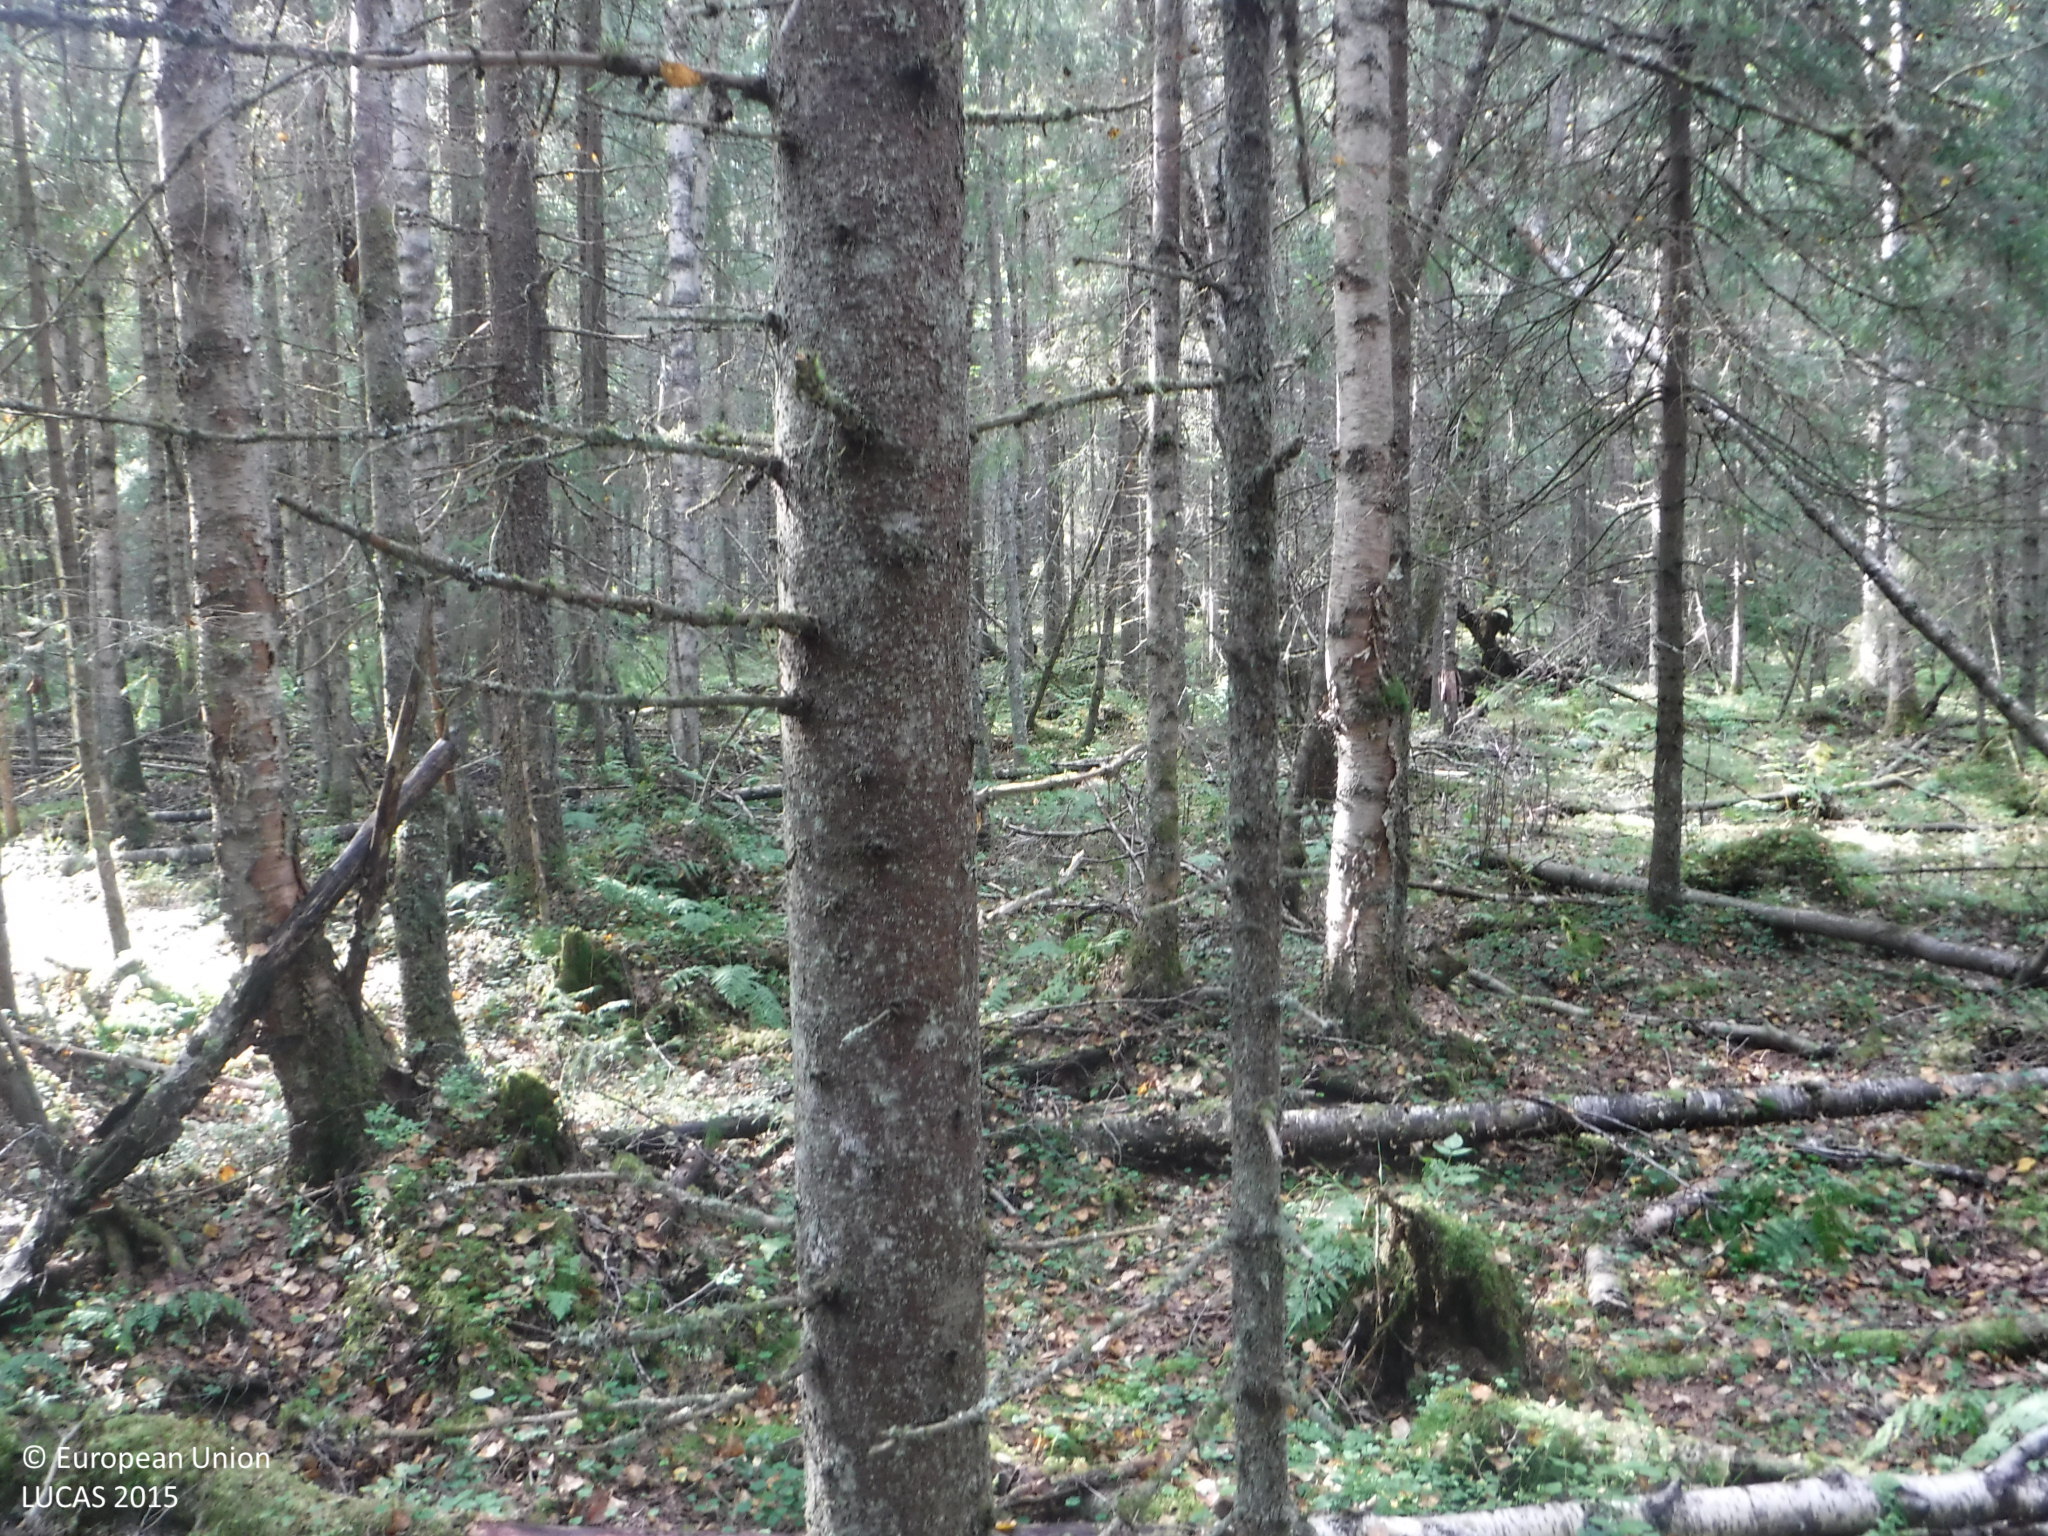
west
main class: Woodland
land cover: Spruce dominated mixed woodland
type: boreal forest
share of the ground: > 75 %
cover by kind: coniferous forest trees 45 %, broadleaved forest trees 30 %, herbaceous plants 15 %, lichens and mosses 10 %
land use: Forestry
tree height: > 5 m
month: September
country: FI
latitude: 61.6979
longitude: 22.3685
